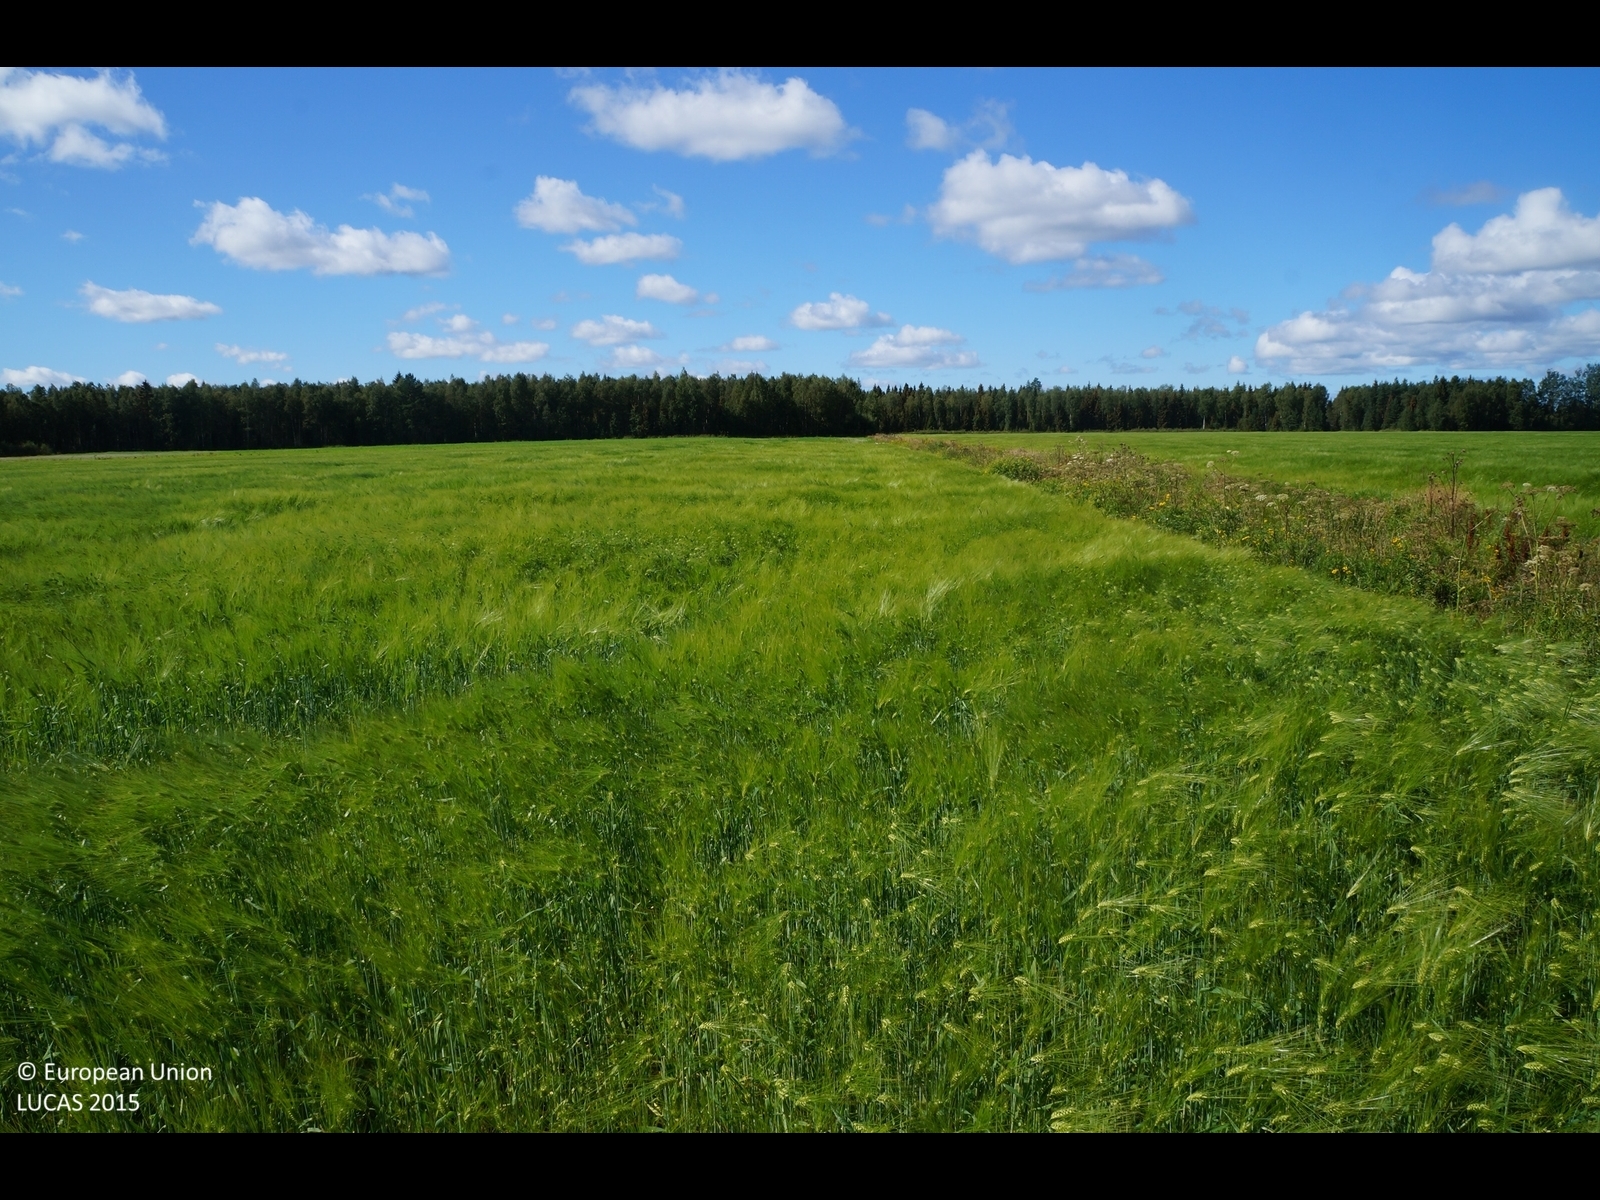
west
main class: Cropland
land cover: Barley
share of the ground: > 75 %
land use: Agriculture (excluding fallow land and kitchen gardens)
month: August
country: FI
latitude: 64.7370
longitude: 25.5229
